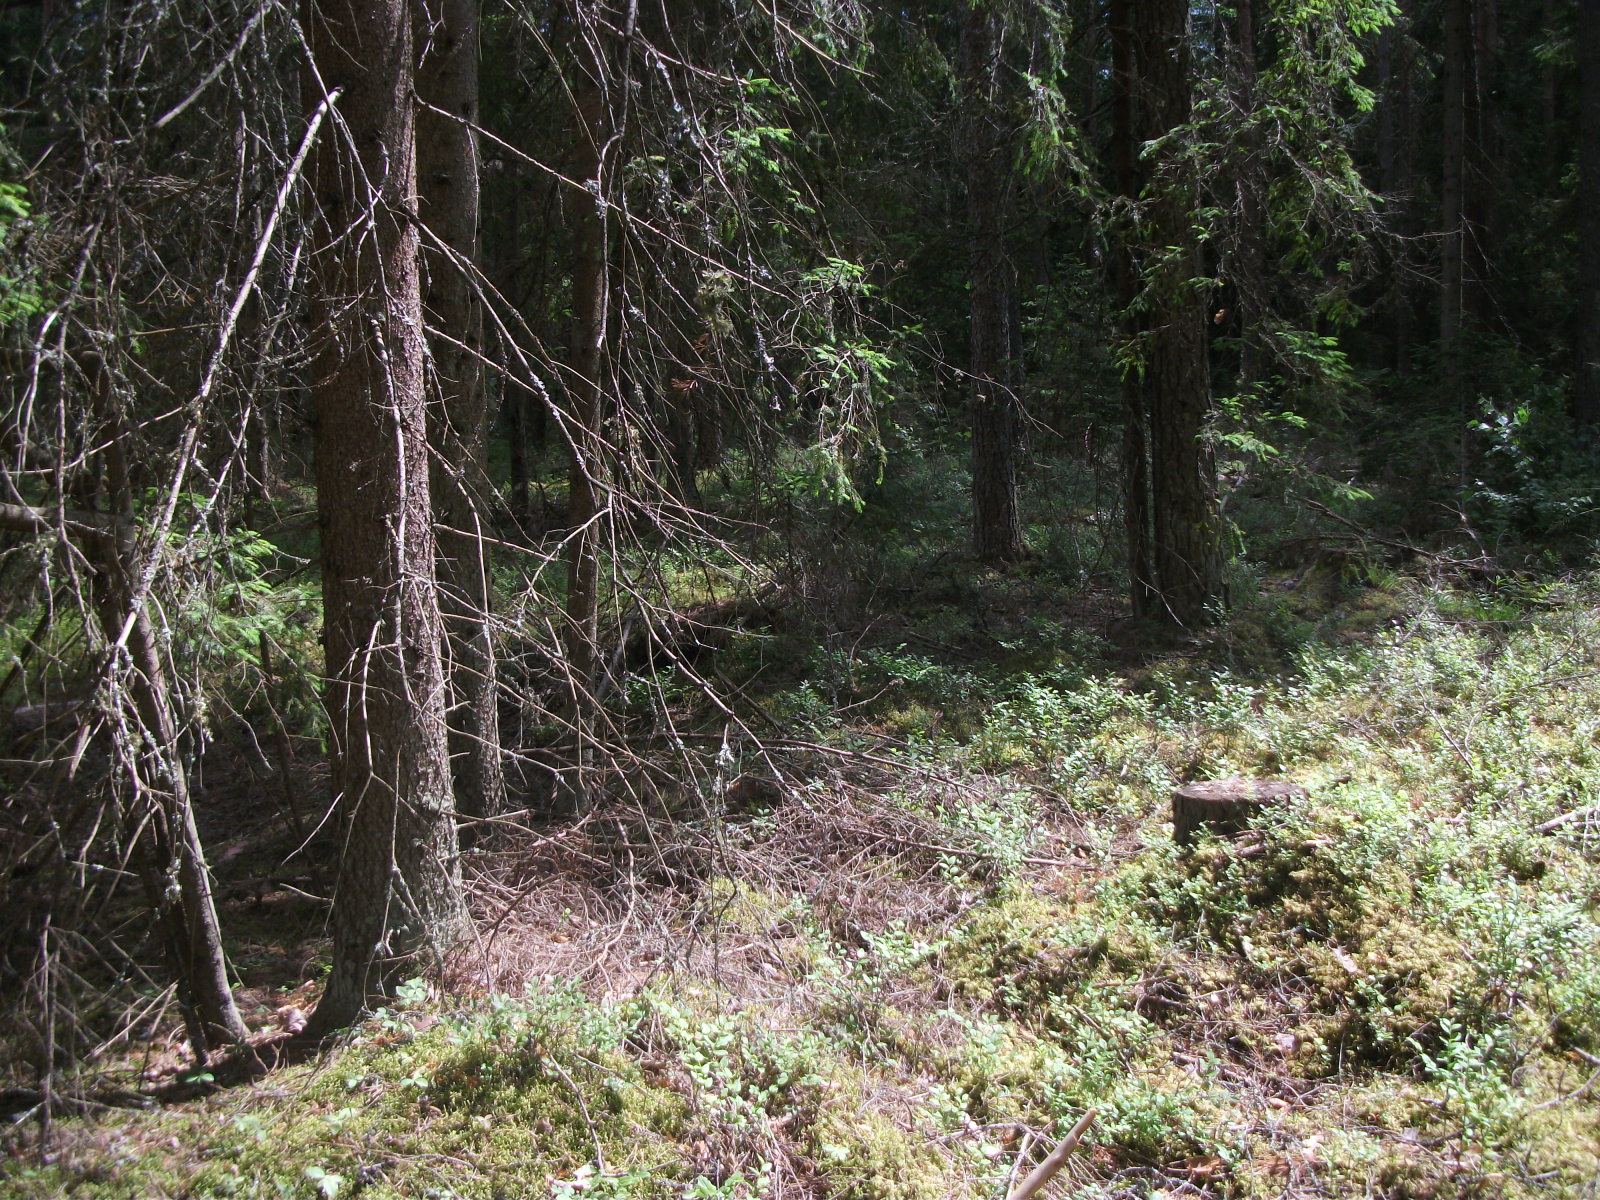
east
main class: Woodland
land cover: Other coniferous woodland
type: hemiboreal forest and nemoral coniferous forest and mixed broadleaved-coniferous forest
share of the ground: > 75 %
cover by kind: coniferous forest trees 85 %, lichens and mosses 10 %, shrubs 5 %
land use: Forestry
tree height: > 5 m
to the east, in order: Other coniferous woodland; Spruce dominated coniferous woodland; Spruce dominated mixed woodland; Spontaneously vegetated surfaces; Inland fresh running water; Spontaneously vegetated surfaces; Spruce dominated mixed woodland; Spruce dominated coniferous woodland; Tracks; Spruce dominated coniferous woodland
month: July
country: LV
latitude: 57.0818
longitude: 26.3253
